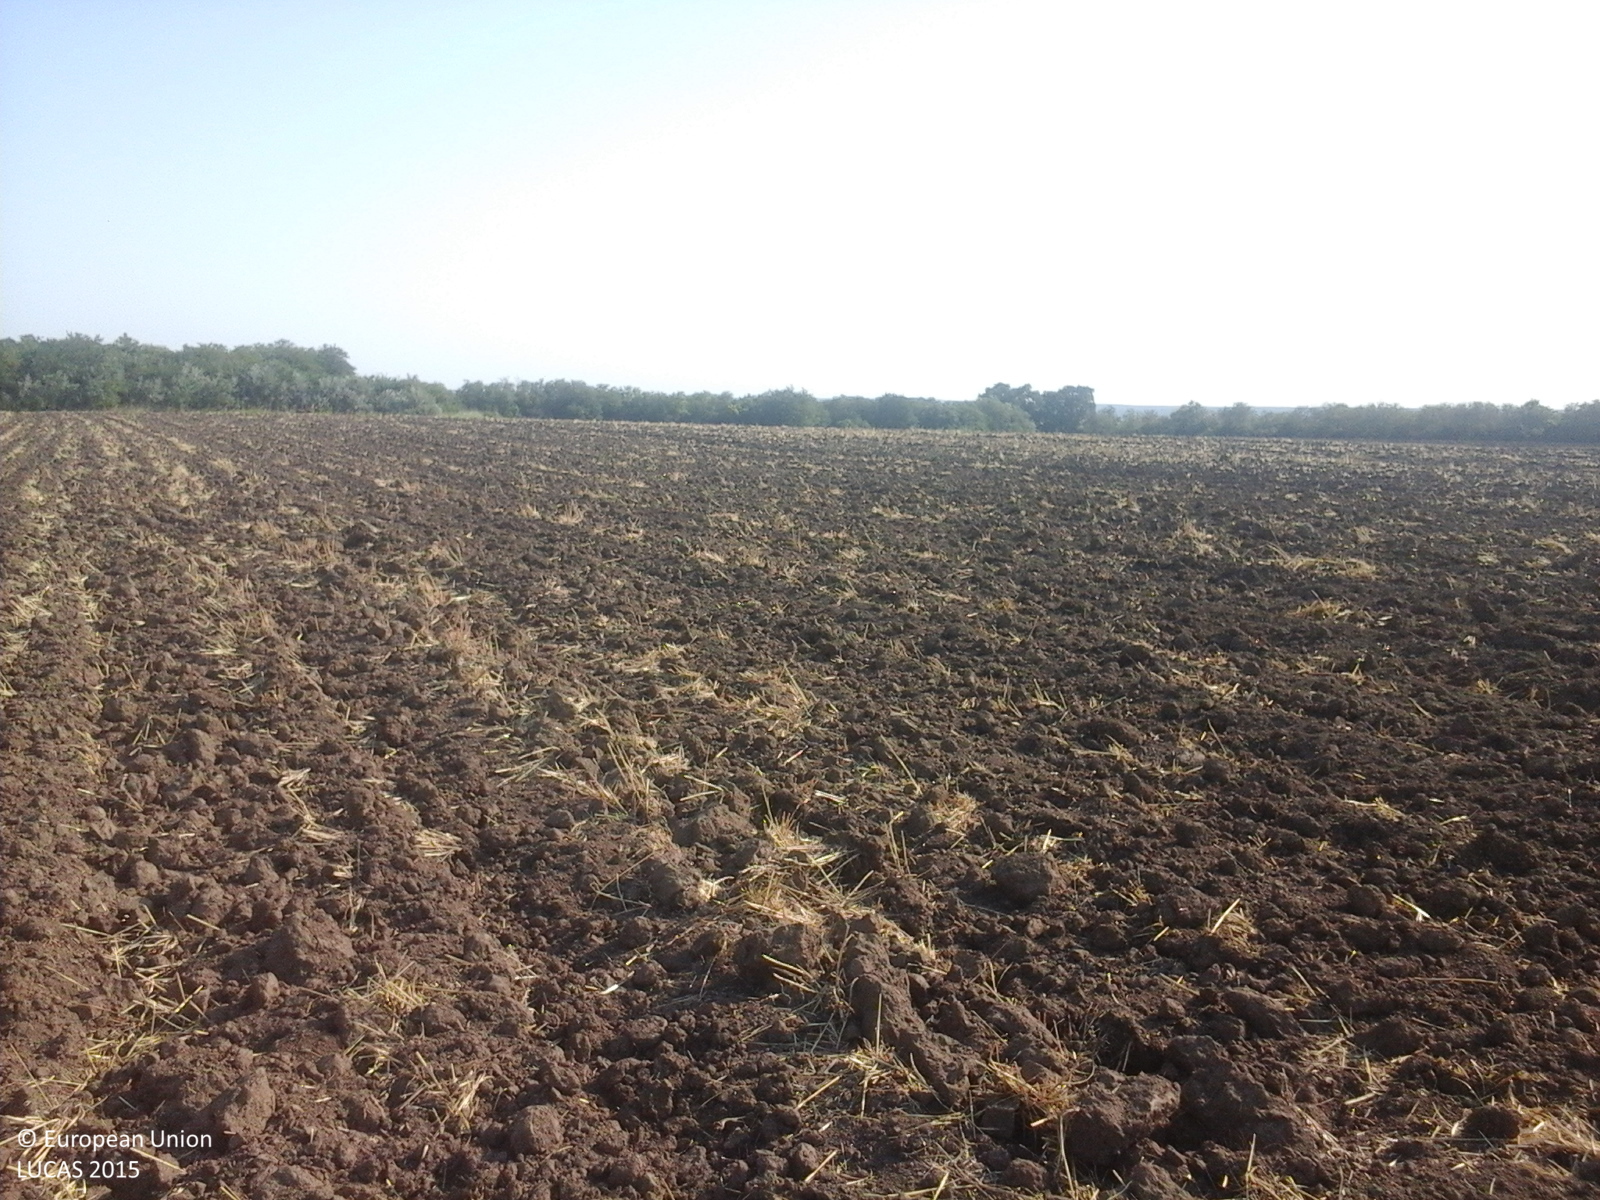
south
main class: Cropland
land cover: Common wheat
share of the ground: < 10 %
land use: Agriculture (excluding fallow land and kitchen gardens)
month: August
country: RO
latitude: 44.0318
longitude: 28.0079
